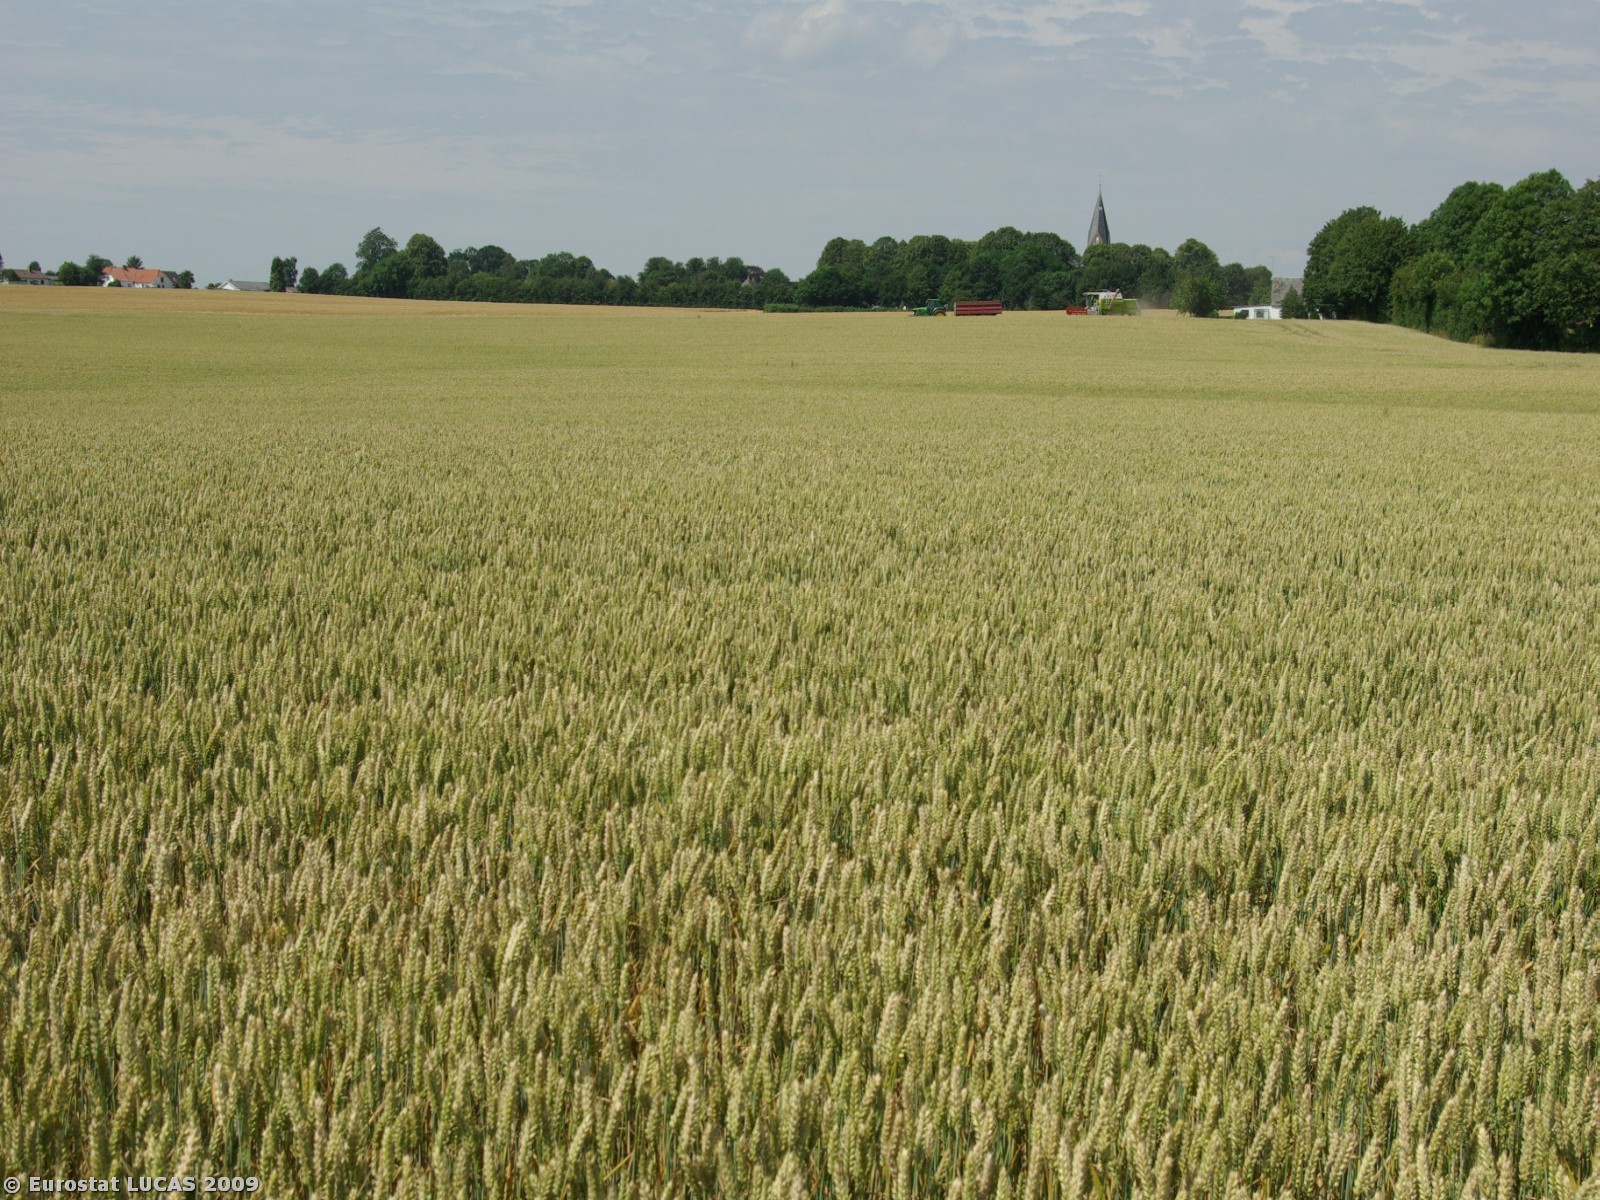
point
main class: Cropland
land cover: Common wheat
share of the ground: > 75 %
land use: Agriculture (excluding fallow land and kitchen gardens)
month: July
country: DK
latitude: 54.9651
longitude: 9.6723
